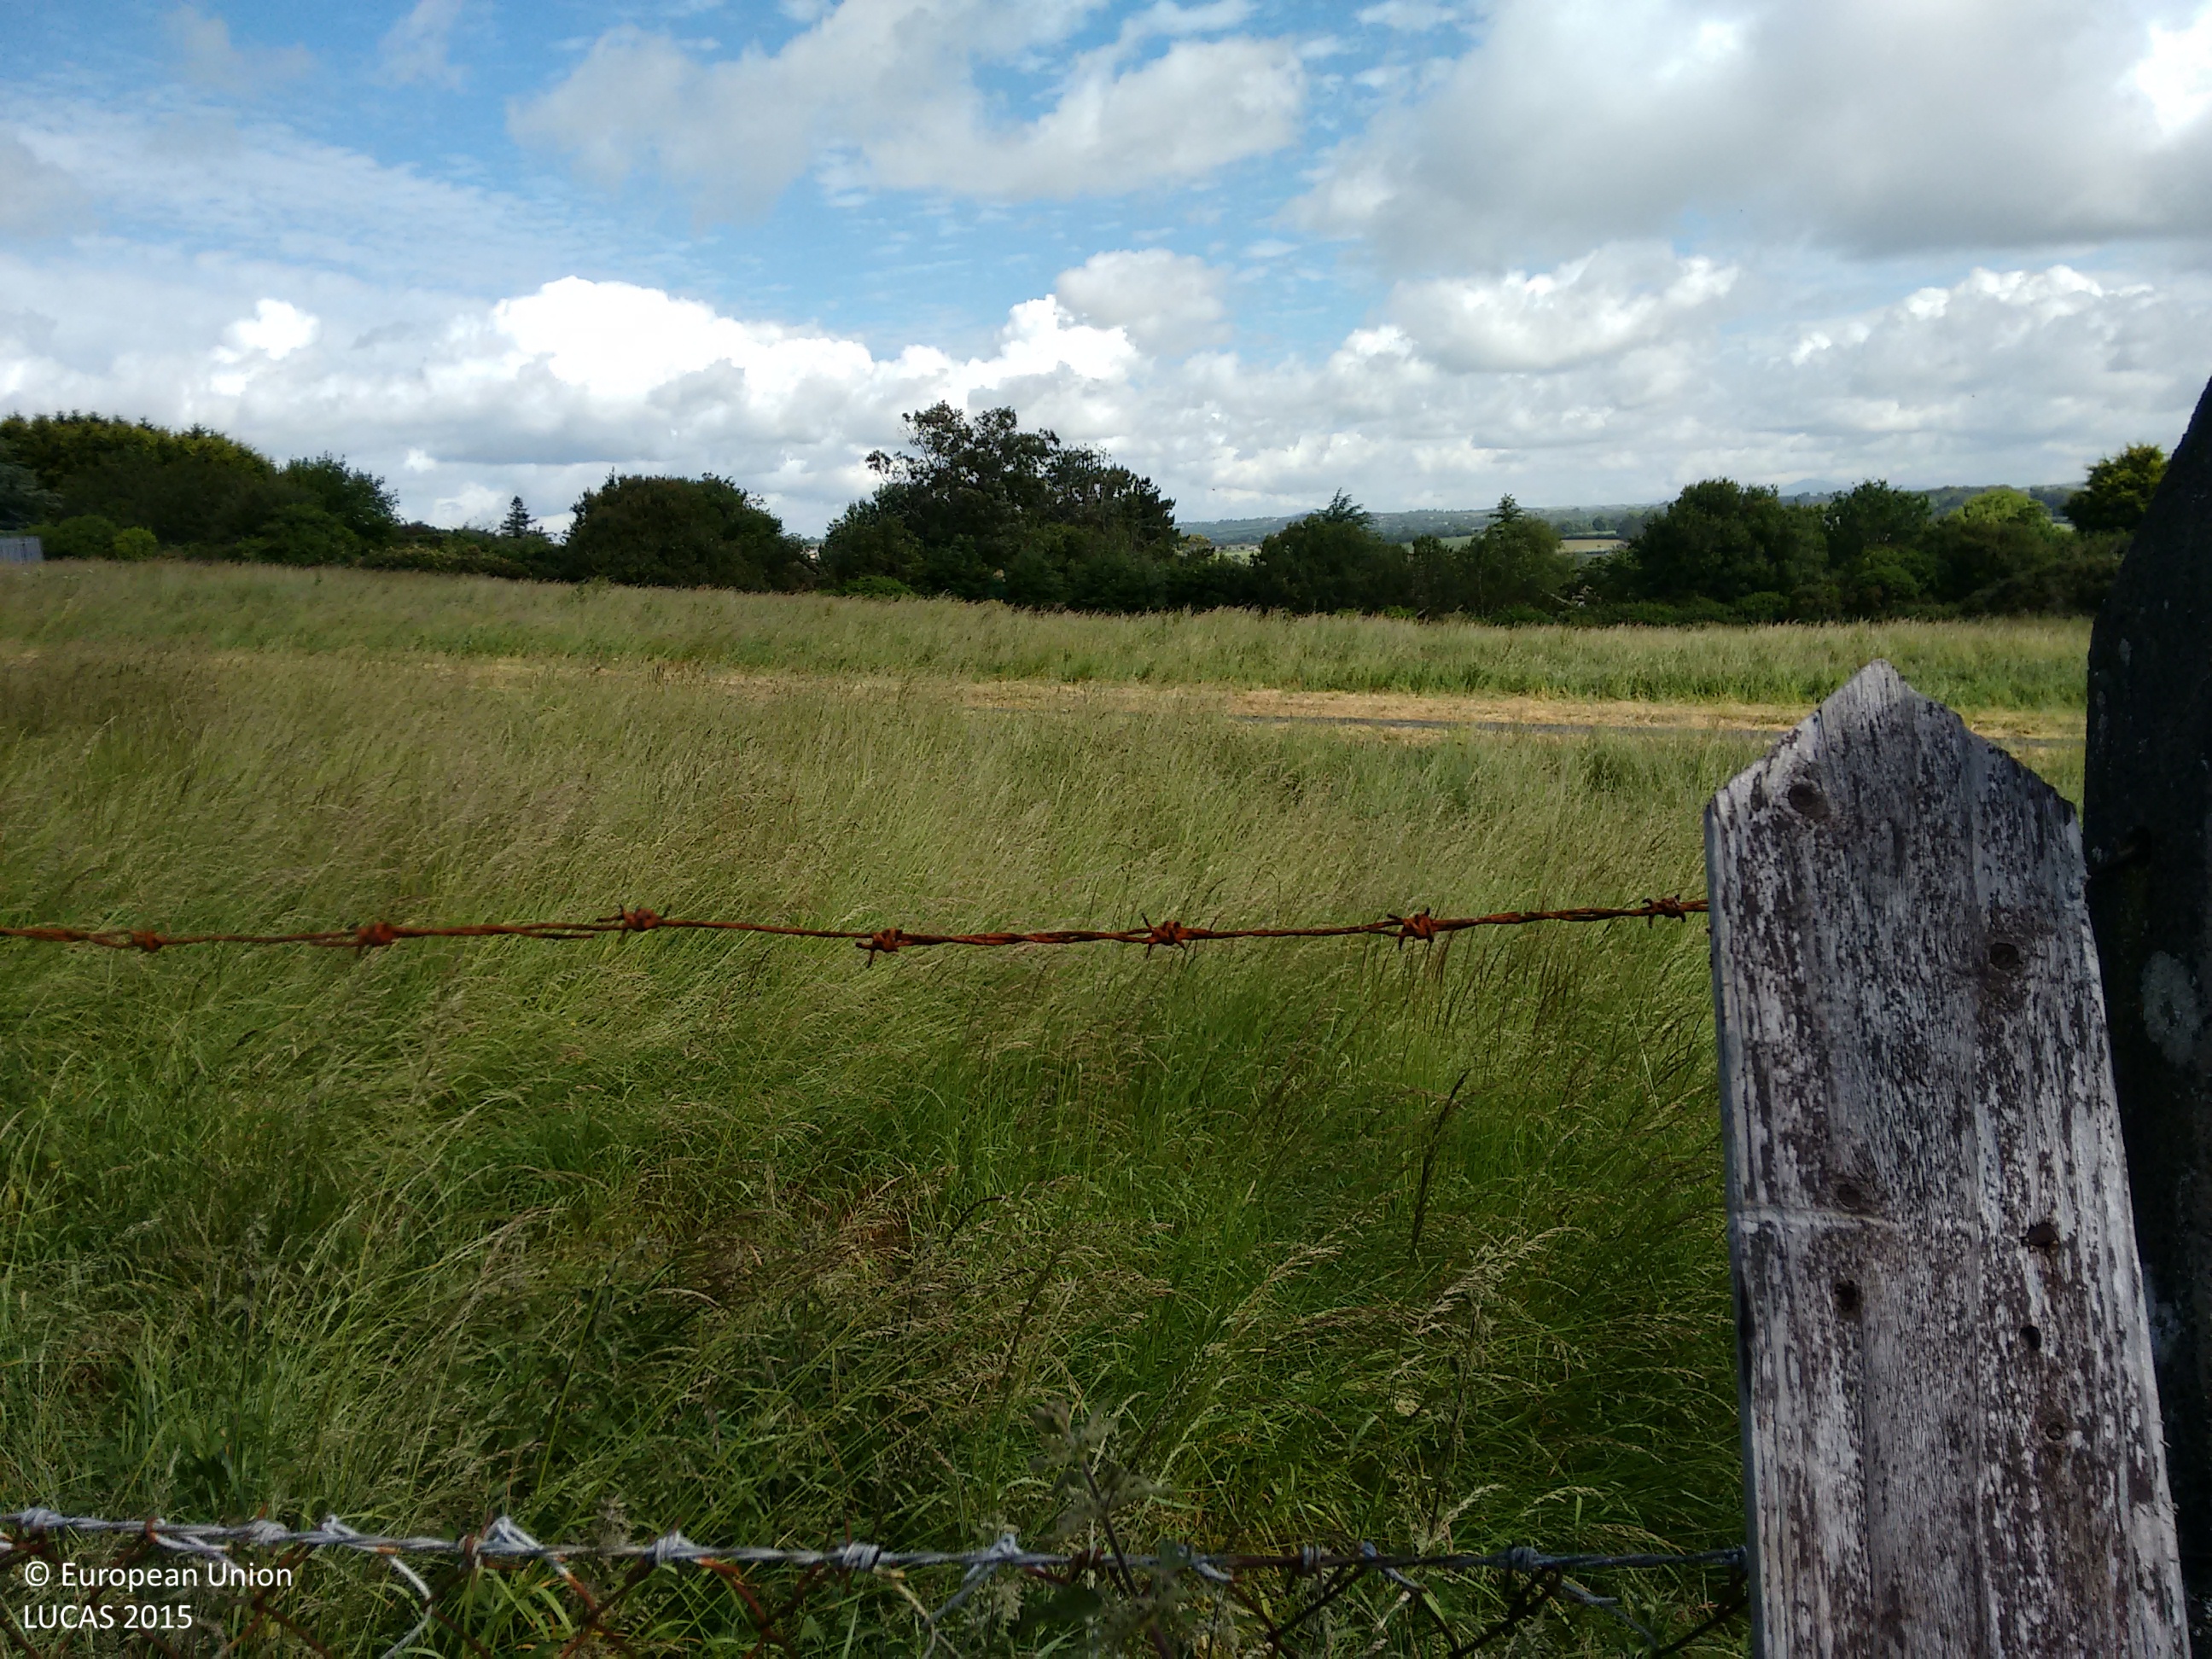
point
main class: Grassland
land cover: Grassland without tree/shrub cover
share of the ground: > 75 %
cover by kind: herbaceous plants 100 %
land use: Semi-natural and natural areas not in use
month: June
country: IE
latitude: 52.2468
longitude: -7.0921
